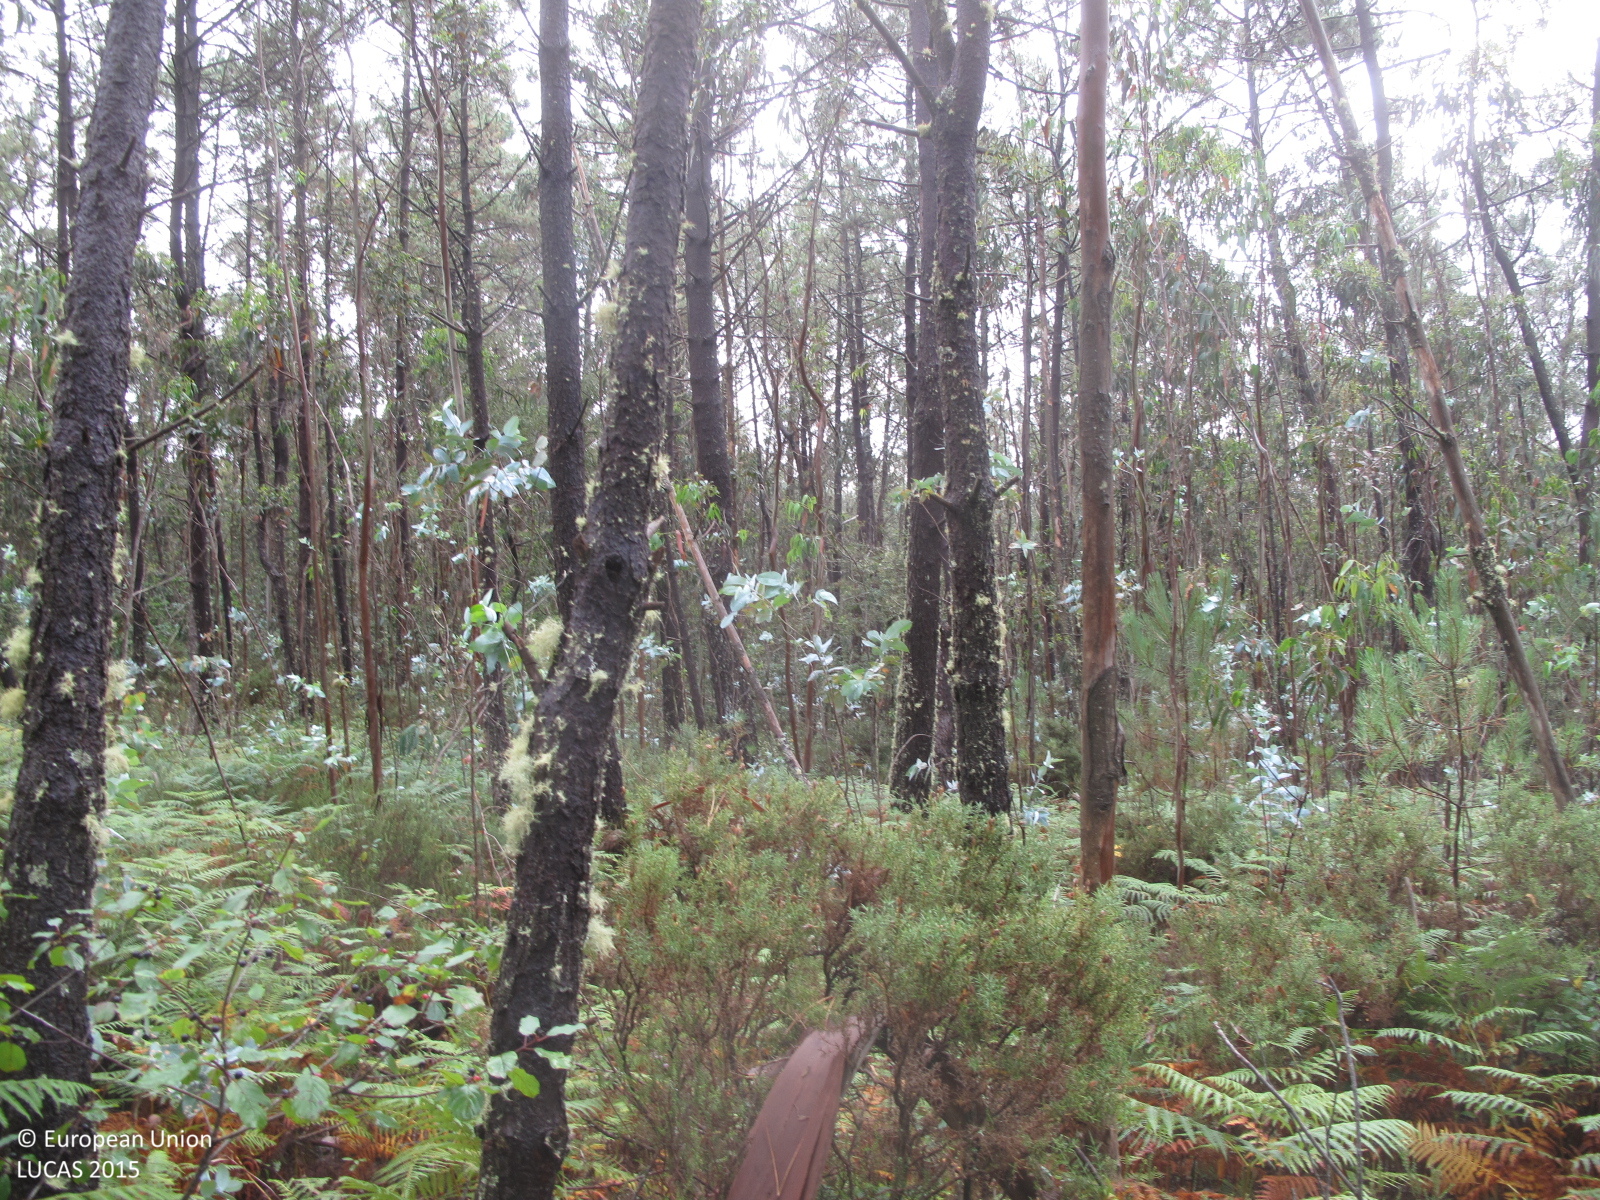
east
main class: Woodland
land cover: Pine dominated mixed woodland
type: hemiboreal forest and nemoral coniferous forest and mixed broadleaved-coniferous forest
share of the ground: 50 - 75 %
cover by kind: coniferous forest trees 40 %, broadleaved forest trees 30 %, shrubs 20 %, herbaceous plants 10 %
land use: Forestry
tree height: > 5 m
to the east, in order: Pine dominated mixed woodland
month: July
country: ES
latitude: 43.0646
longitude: -9.1481
